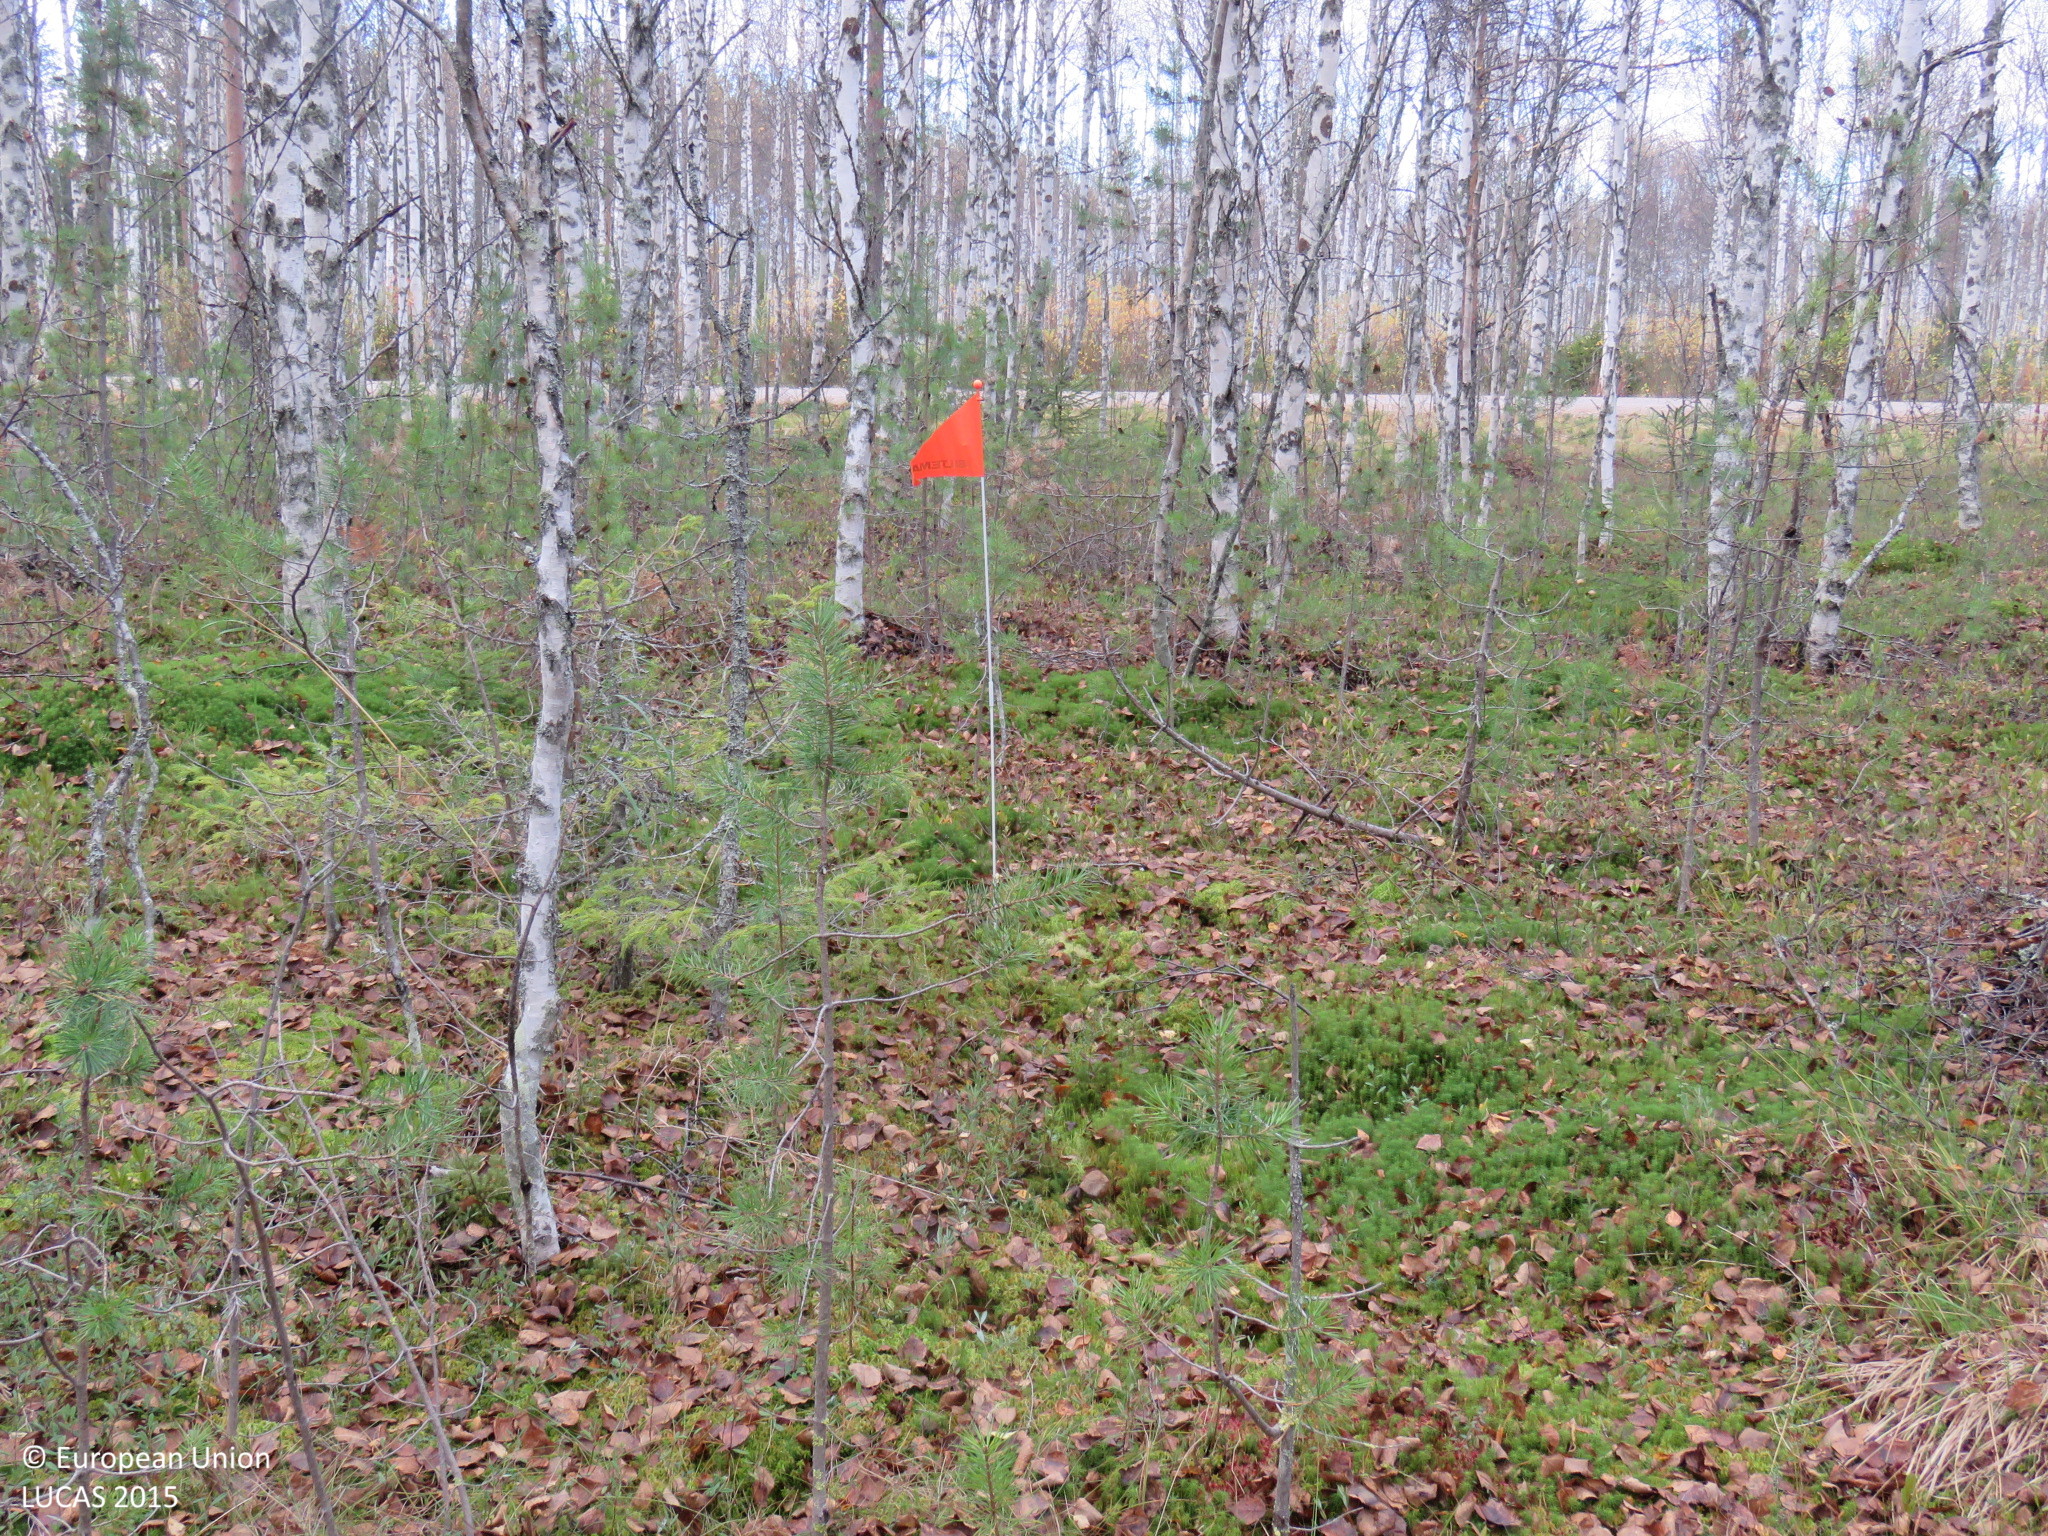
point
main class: Woodland
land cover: Pine dominated mixed woodland
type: mire and swamp forests
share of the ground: > 75 %
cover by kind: broadleaved forest trees 50 %, coniferous forest trees 35 %, shrubs 5 %, herbaceous plants 5 %, lichens and mosses 5 %
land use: Forestry
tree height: > 5 m
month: September
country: FI
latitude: 64.9134
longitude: 27.2304
